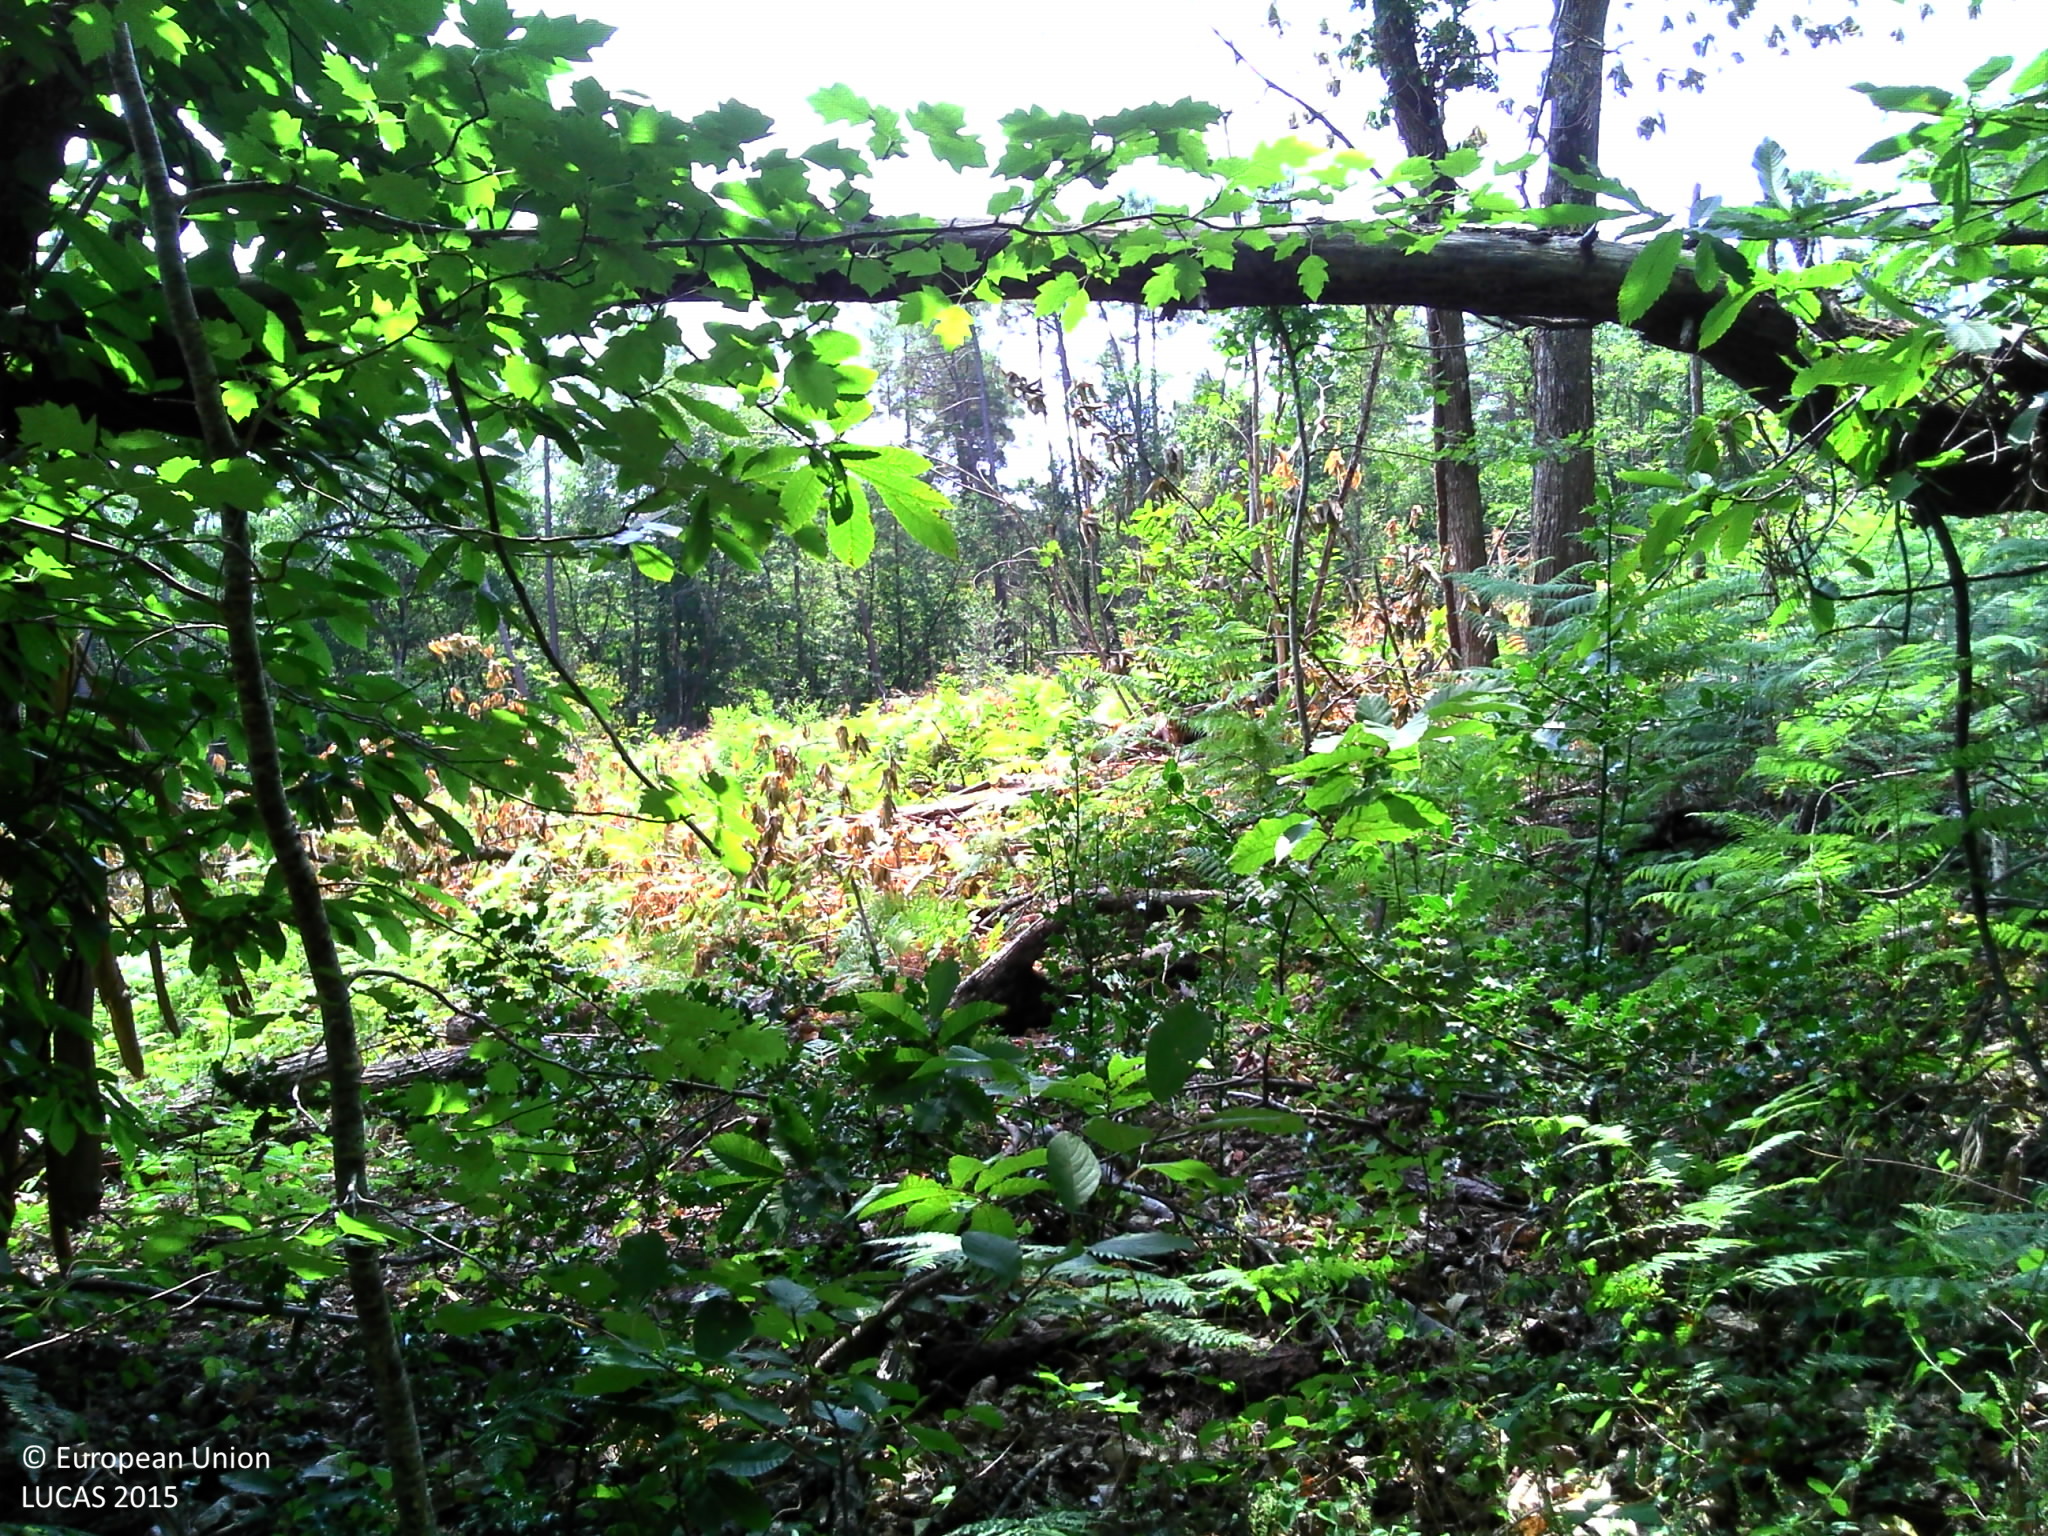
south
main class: Woodland
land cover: Broadleaved woodland
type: mesophytic deciduous forest
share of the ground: > 75 %
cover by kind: broadleaved forest trees 90 %, herbaceous plants 10 %
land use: Forestry
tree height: > 5 m
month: July
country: FR
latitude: 45.1514
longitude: 0.7435
